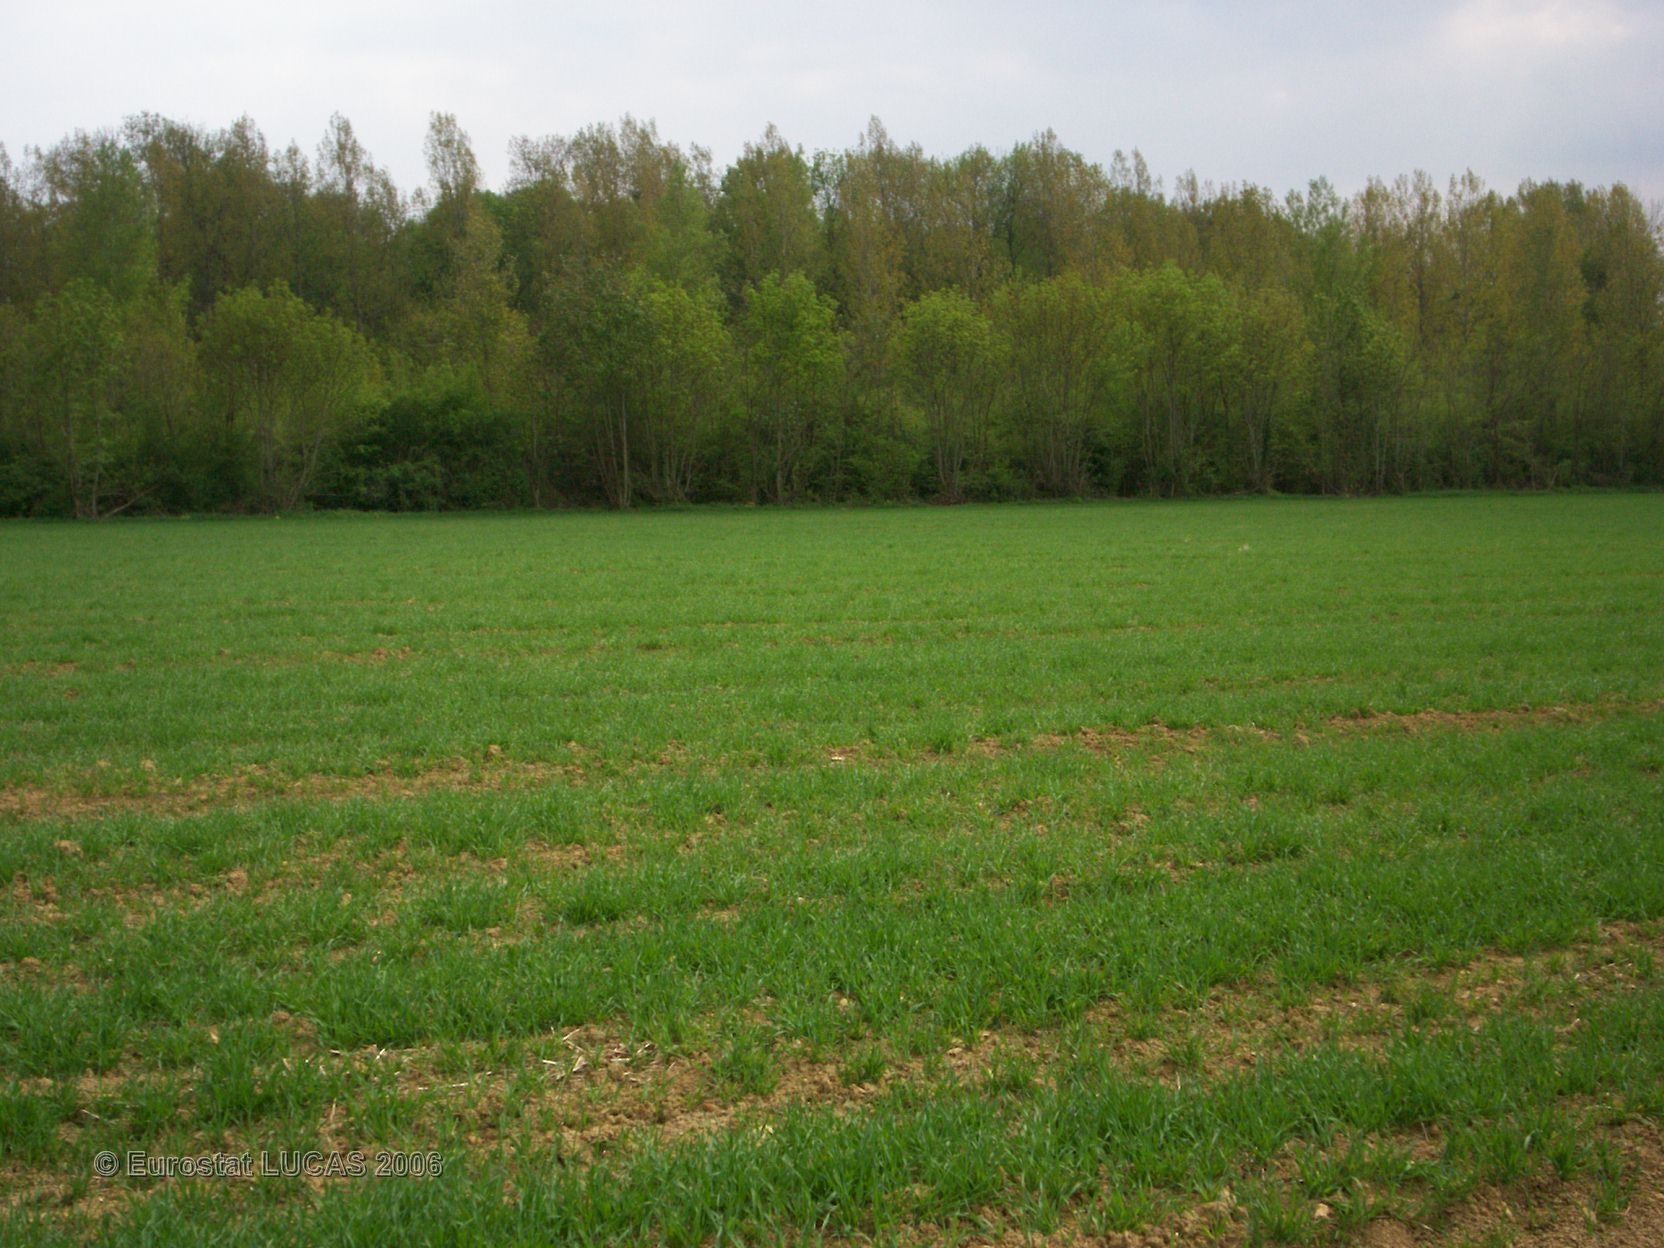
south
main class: Cropland
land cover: Barley
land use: Agriculture (excluding fallow land and kitchen gardens)
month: April
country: FR
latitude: 47.1027
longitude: 3.0781
